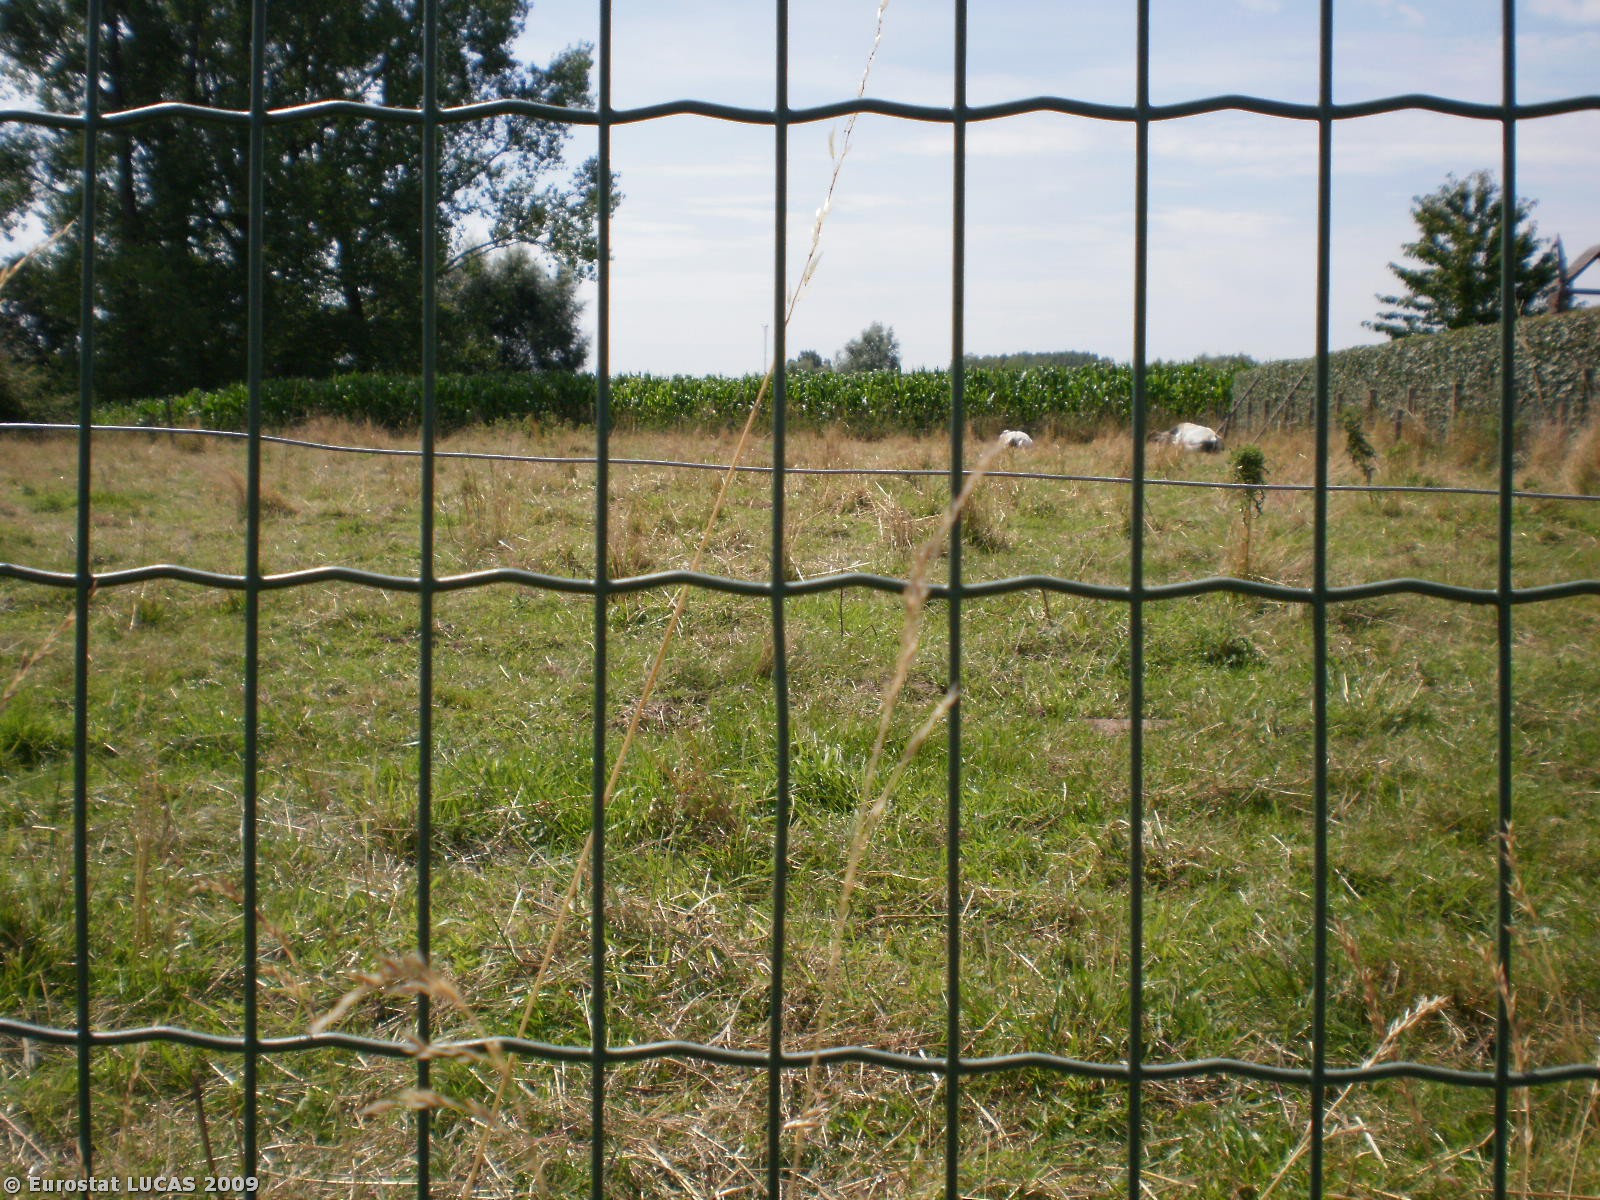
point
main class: Grassland
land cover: Grassland without tree/shrub cover
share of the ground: > 75 %
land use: Agriculture (excluding fallow land and kitchen gardens)
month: July
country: BE
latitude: 51.0470
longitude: 4.2179
